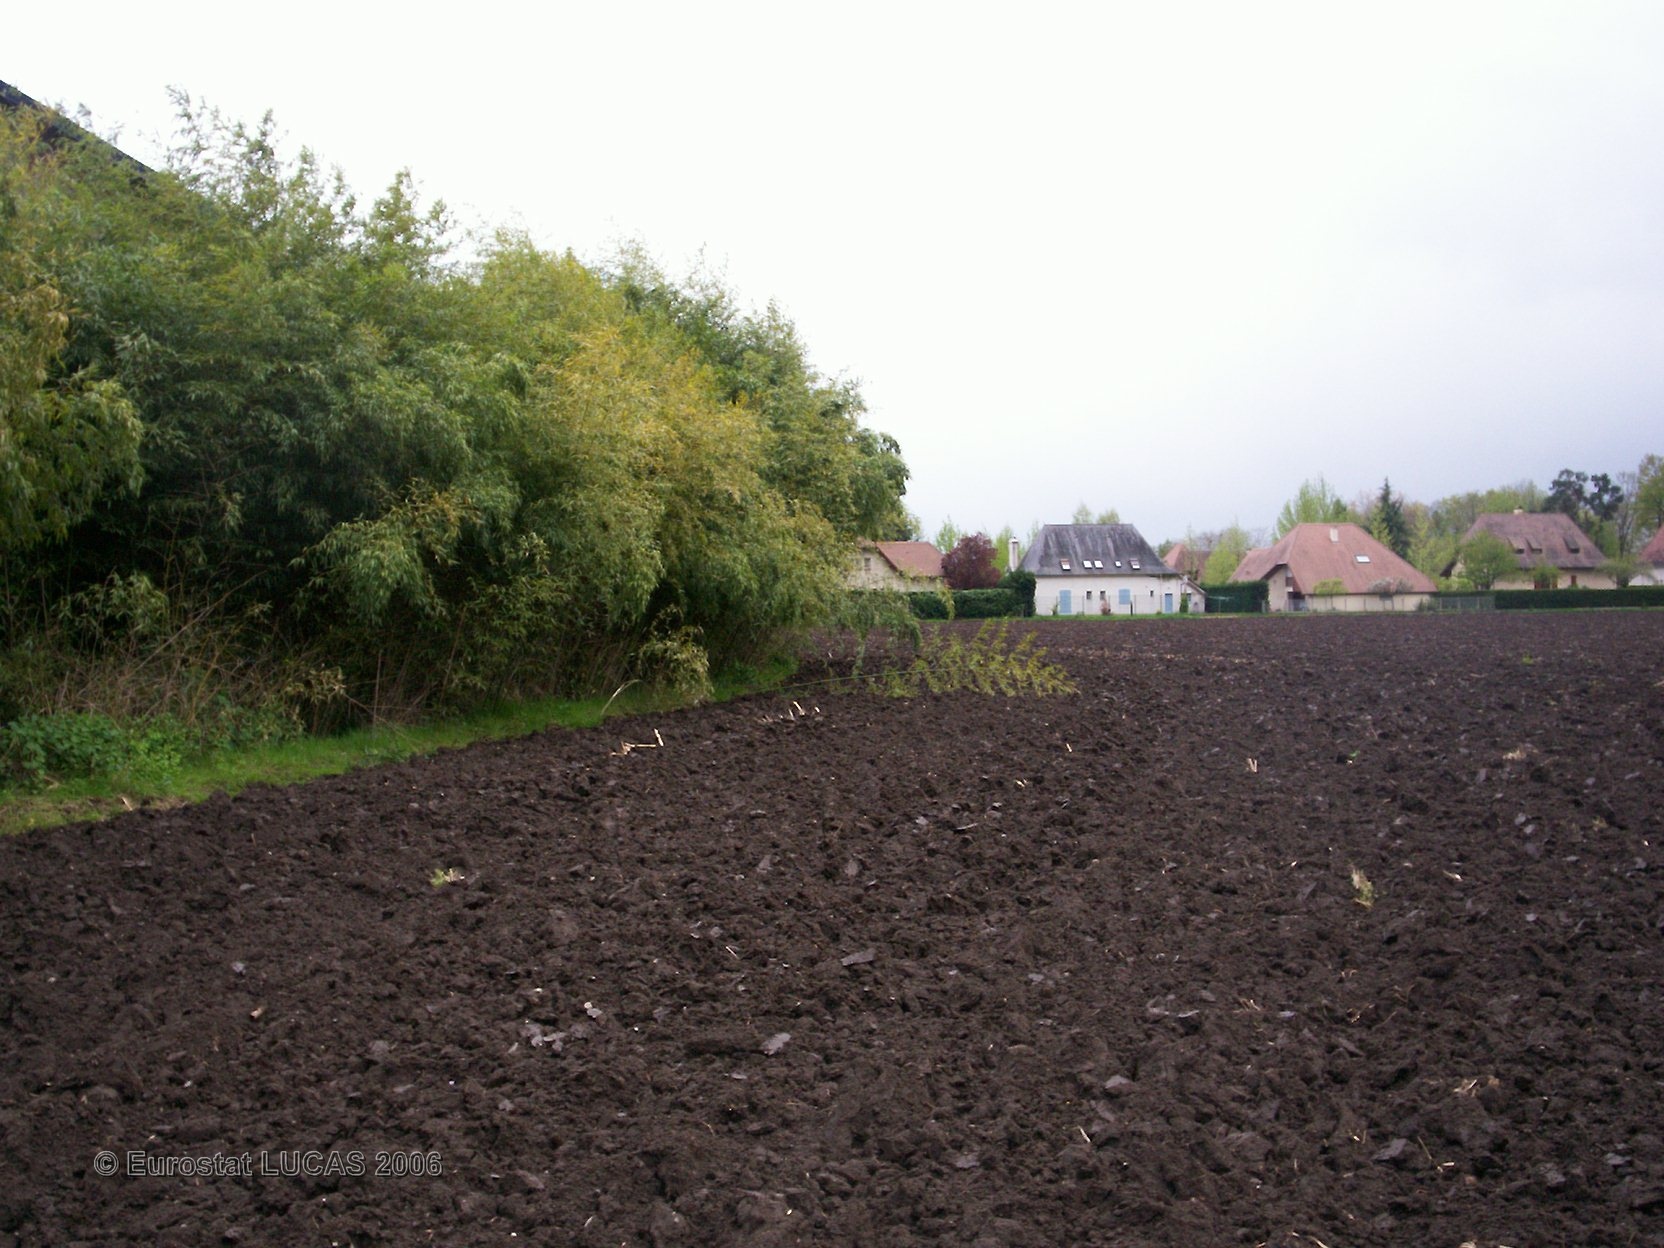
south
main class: Cropland
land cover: Maize
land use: Agriculture (excluding fallow land and kitchen gardens)
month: June
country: FR
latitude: 43.3378
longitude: -0.3804
